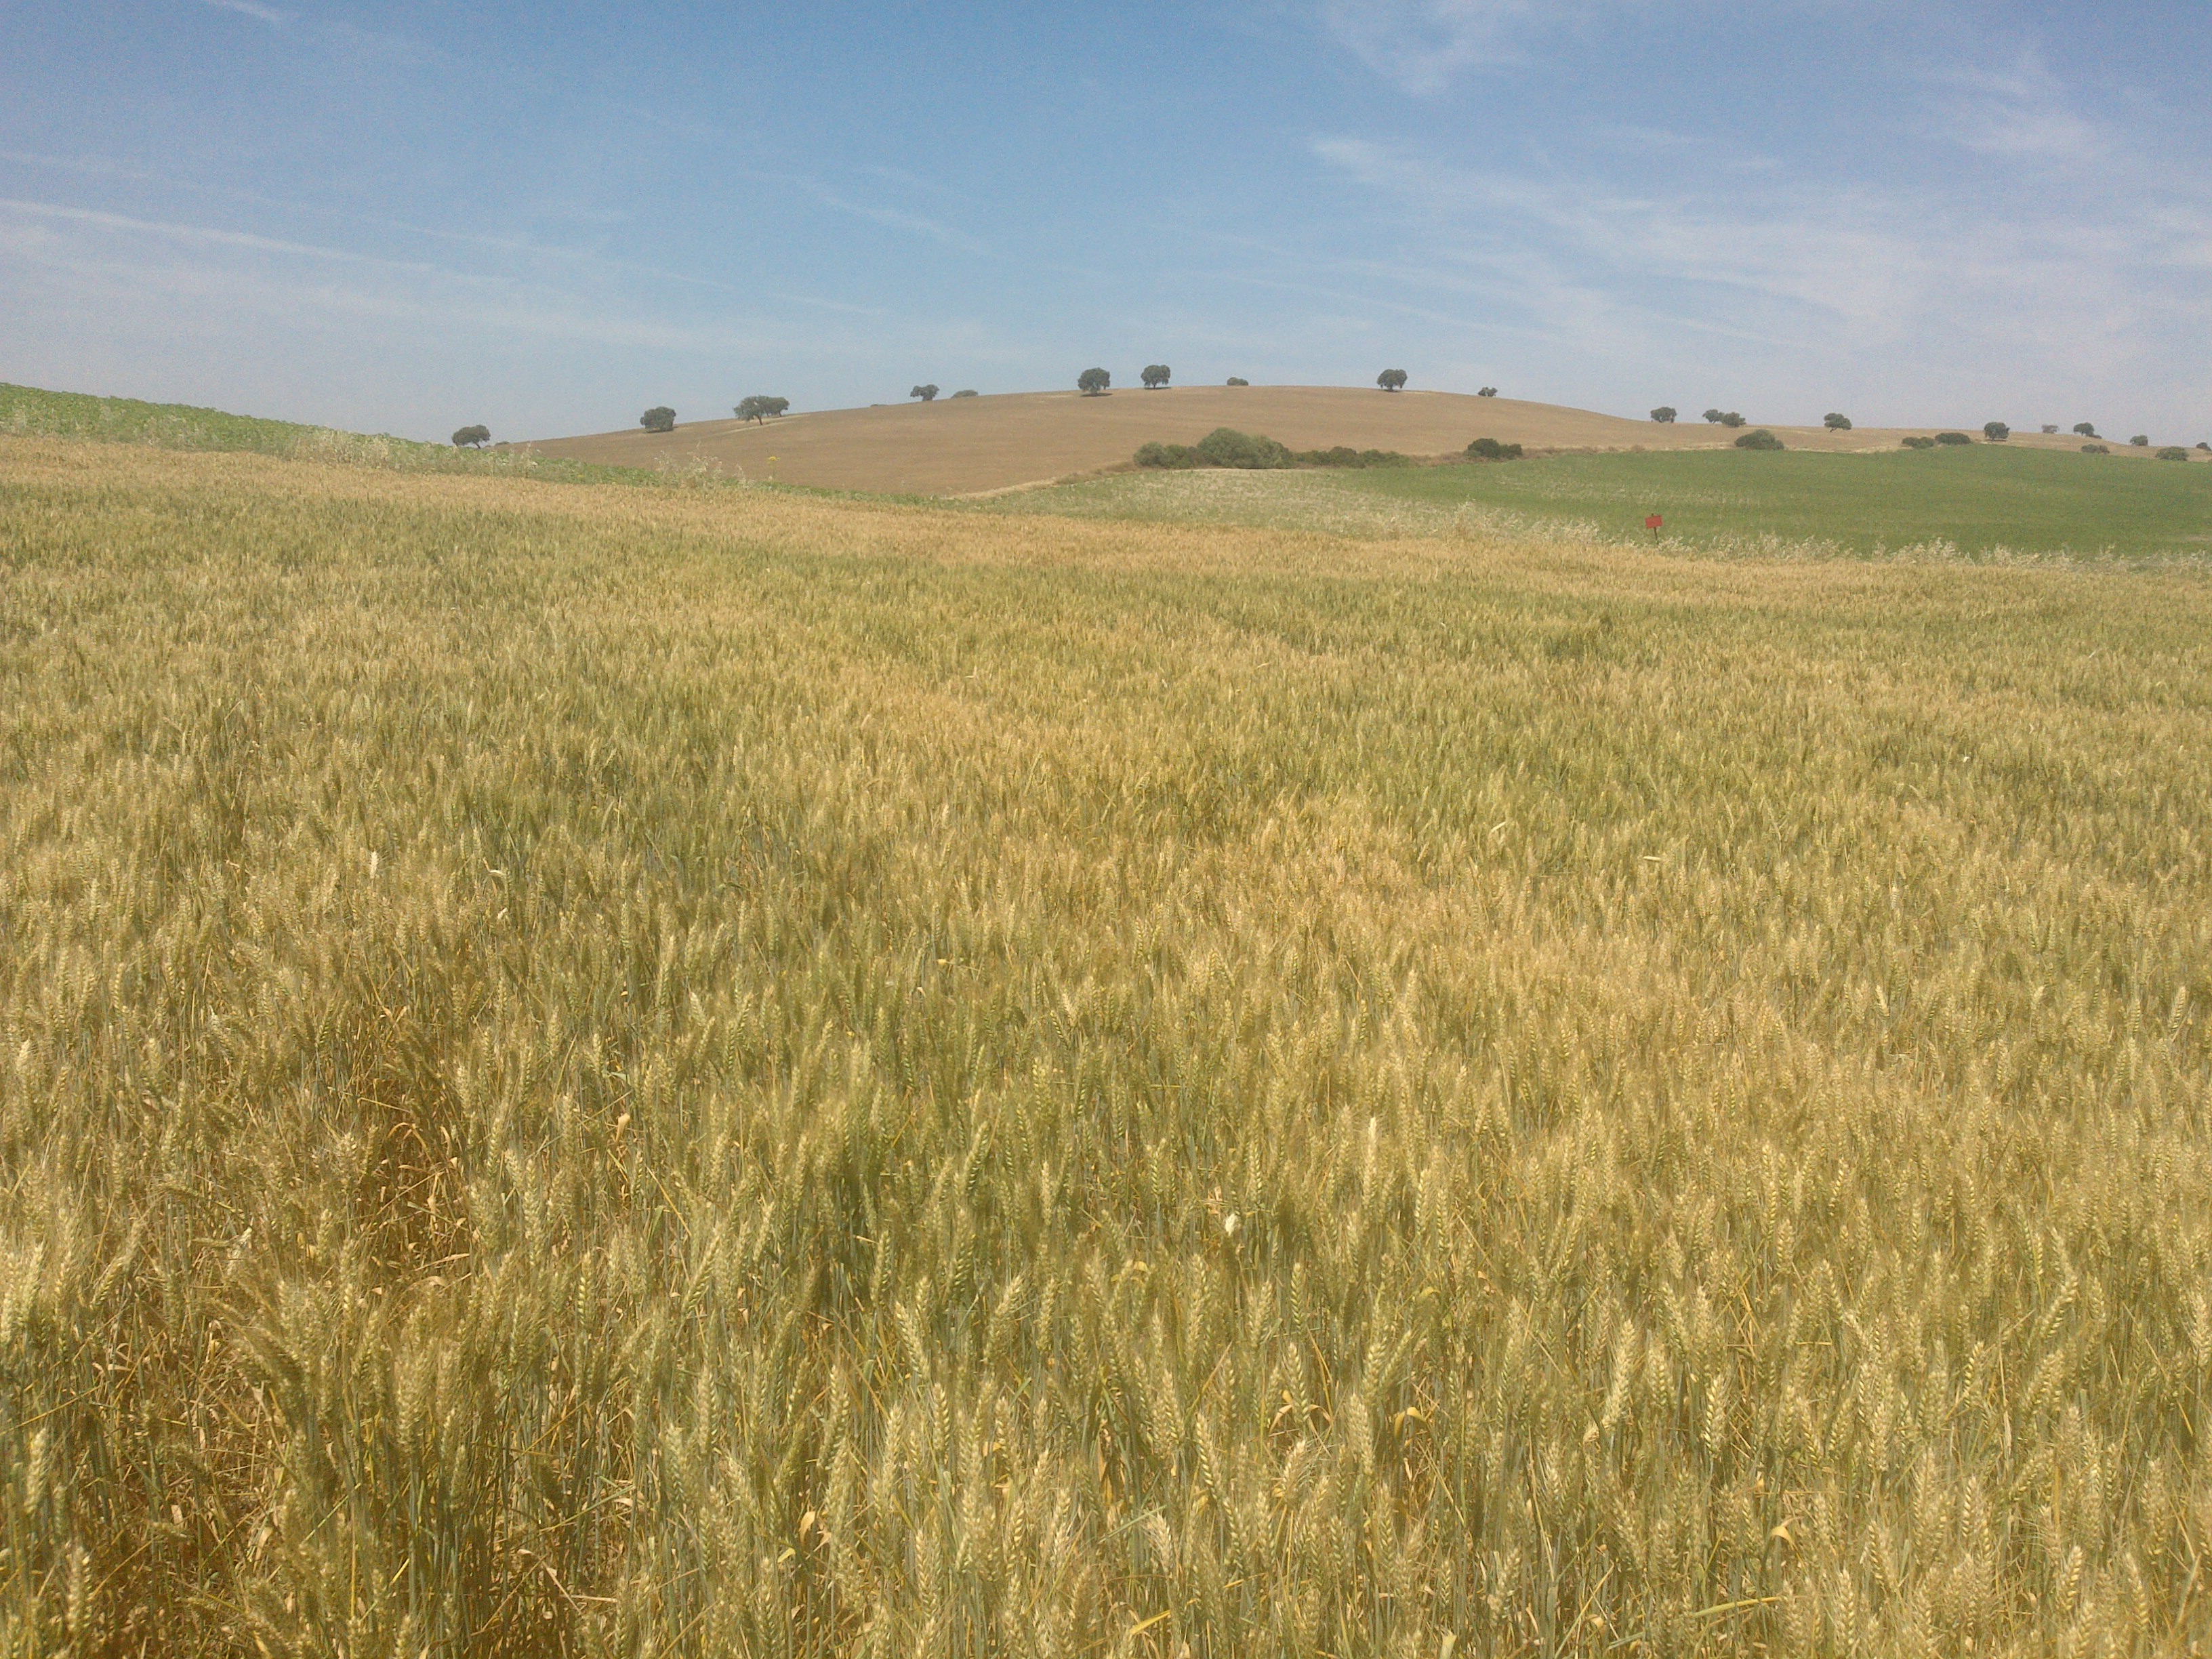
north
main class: Cropland
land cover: Durum wheat
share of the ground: > 75 %
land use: Agriculture (excluding fallow land and kitchen gardens)
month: May
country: ES
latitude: 37.8405
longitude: -4.6364
